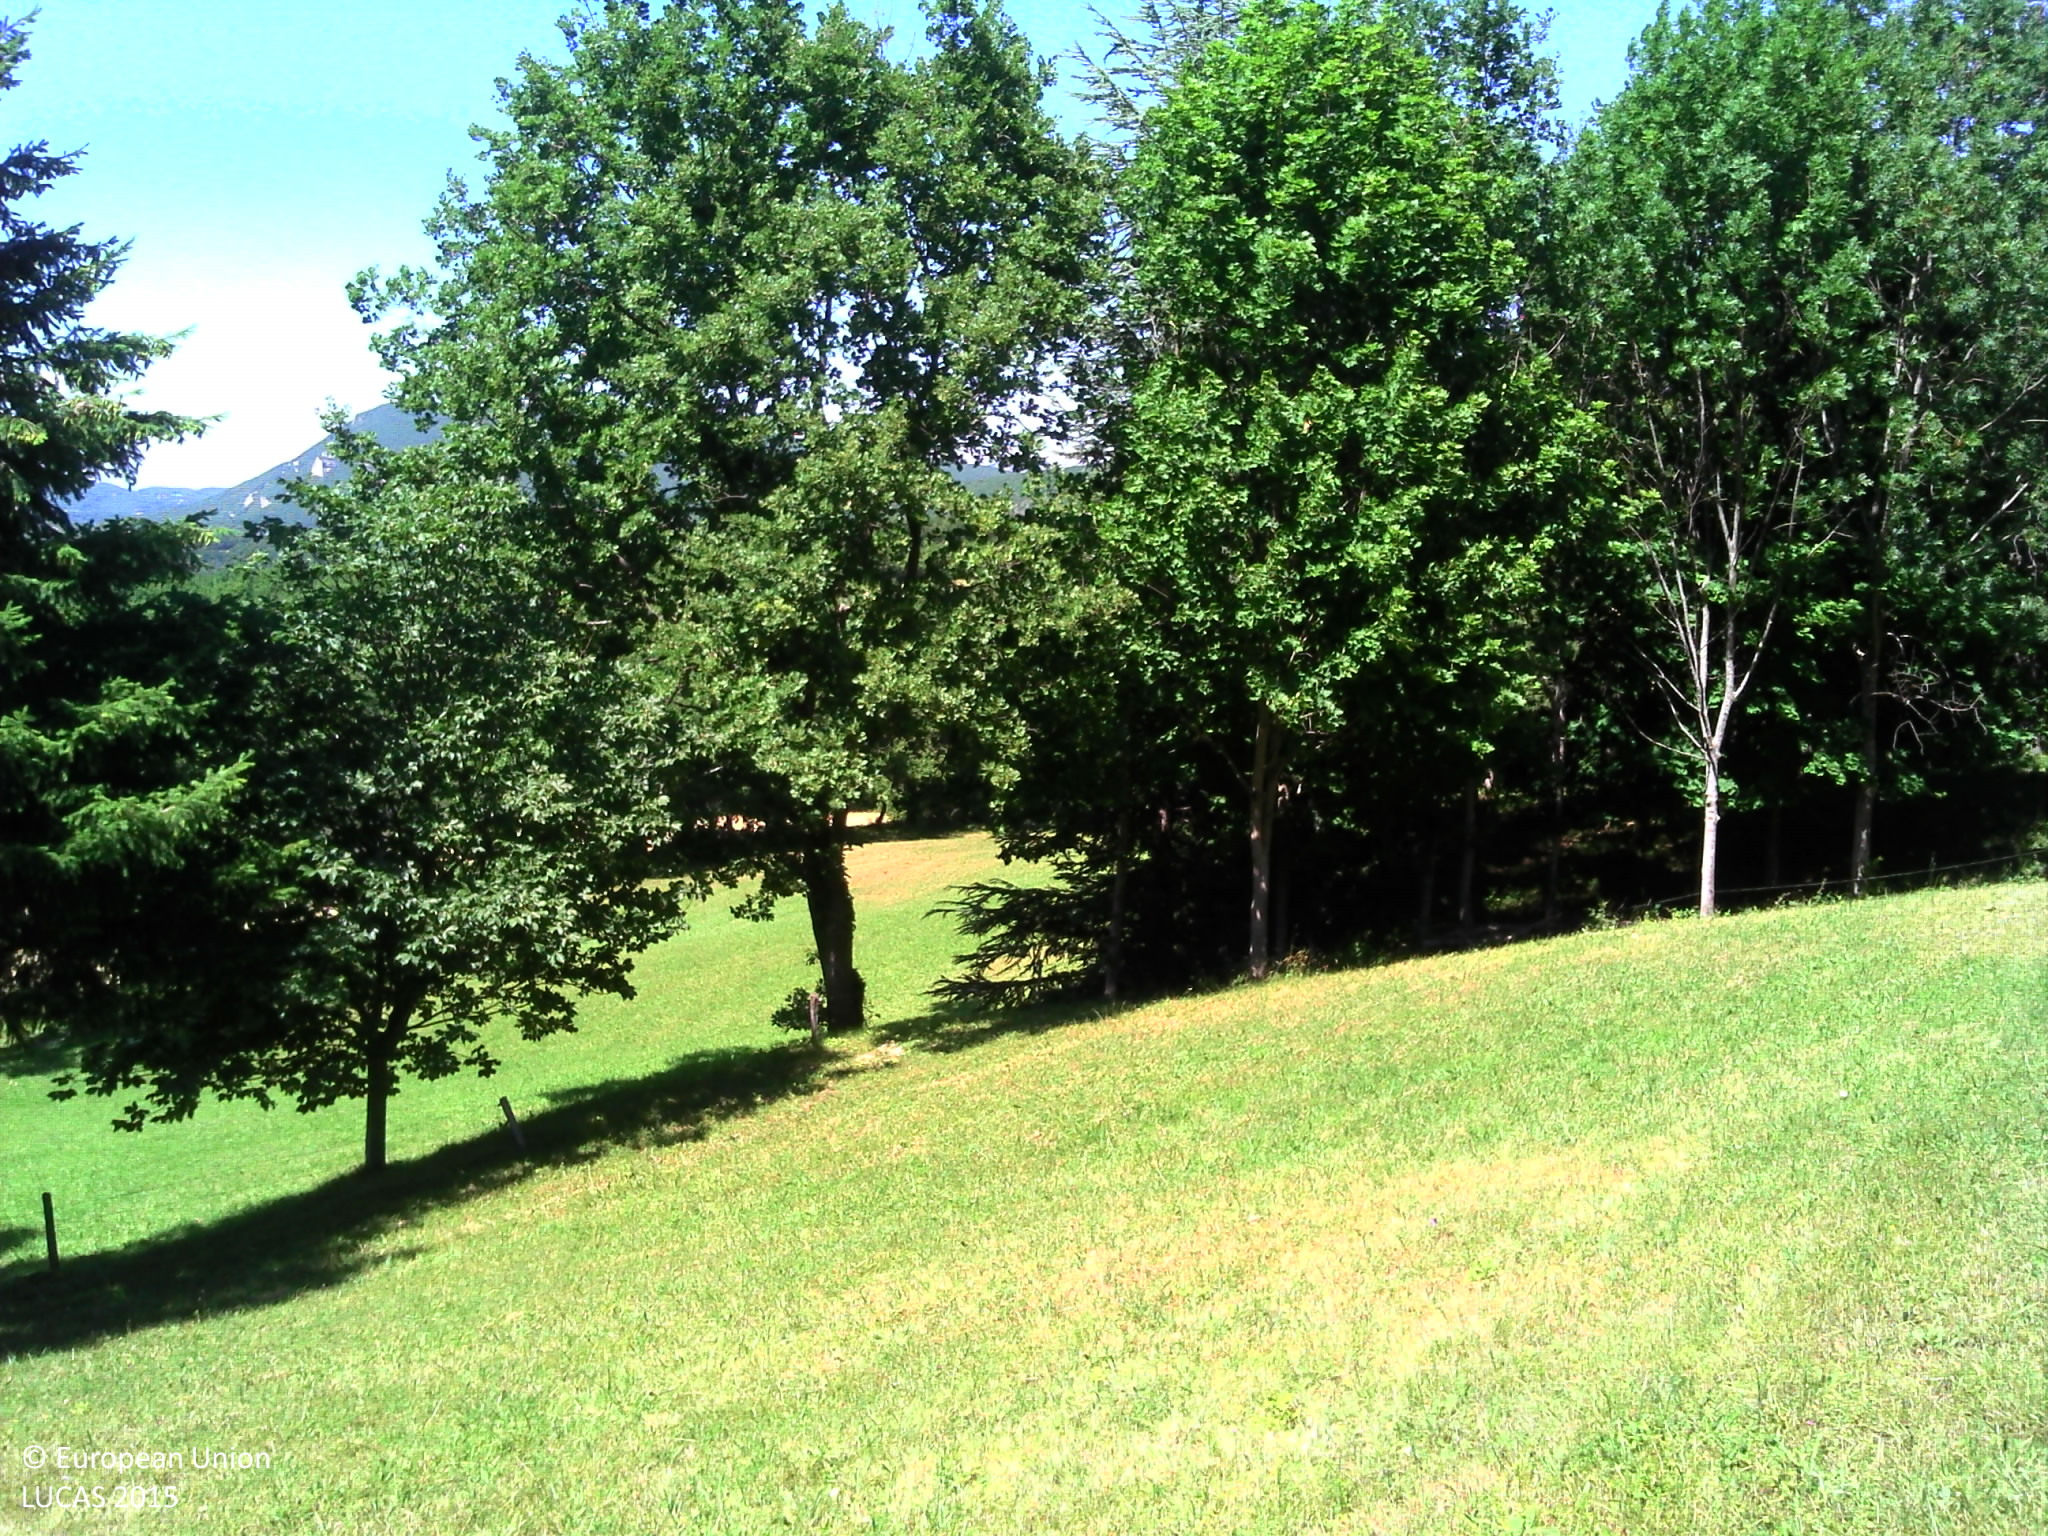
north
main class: Grassland
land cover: Grassland with sparse tree/shrub cover
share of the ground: > 75 %
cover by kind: herbaceous plants 95 %, broadleaved forest trees 5 %
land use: Agriculture (excluding fallow land and kitchen gardens)
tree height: > 5 m
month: June
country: FR
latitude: 44.5737
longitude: 5.0074
